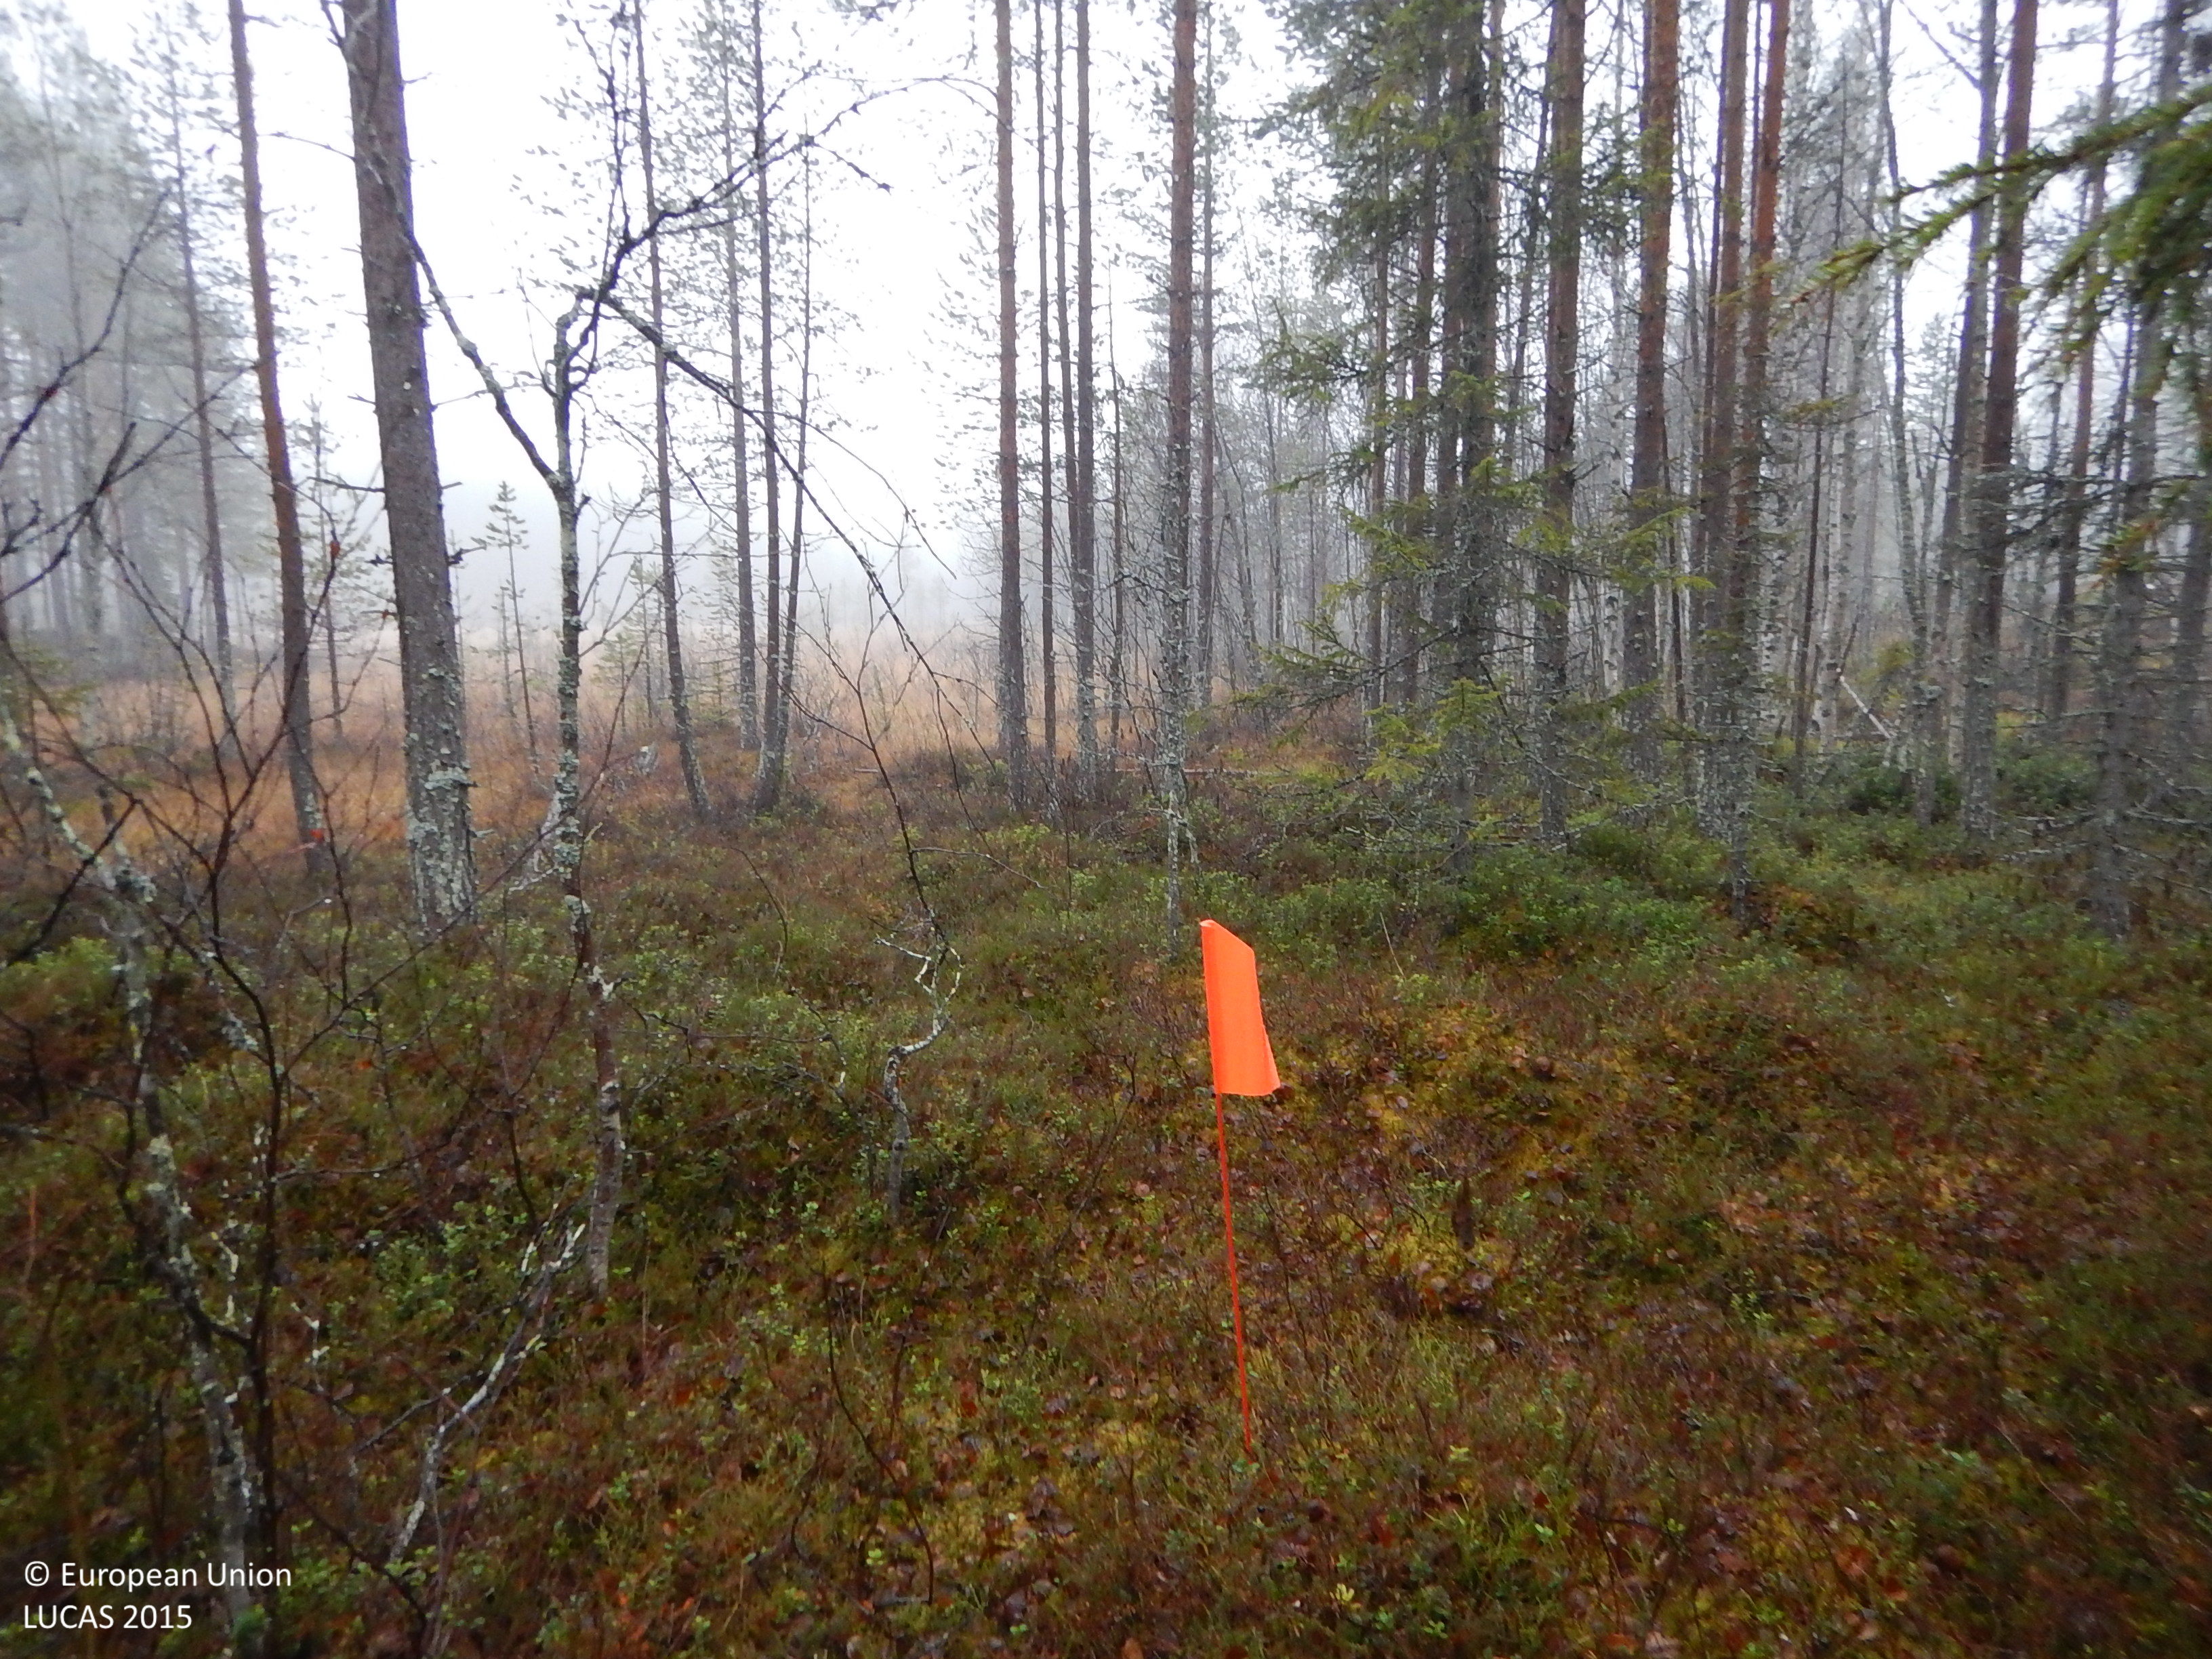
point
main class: Woodland
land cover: Pine dominated mixed woodland
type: mire and swamp forests
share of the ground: 50 - 75 %
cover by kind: coniferous forest trees 35 %, lichens and mosses 25 %, broadleaved forest trees 20 %, shrubs 15 %, herbaceous plants 5 %
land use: Forestry
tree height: > 5 m
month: November
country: SE
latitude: 65.1359
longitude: 20.3503
